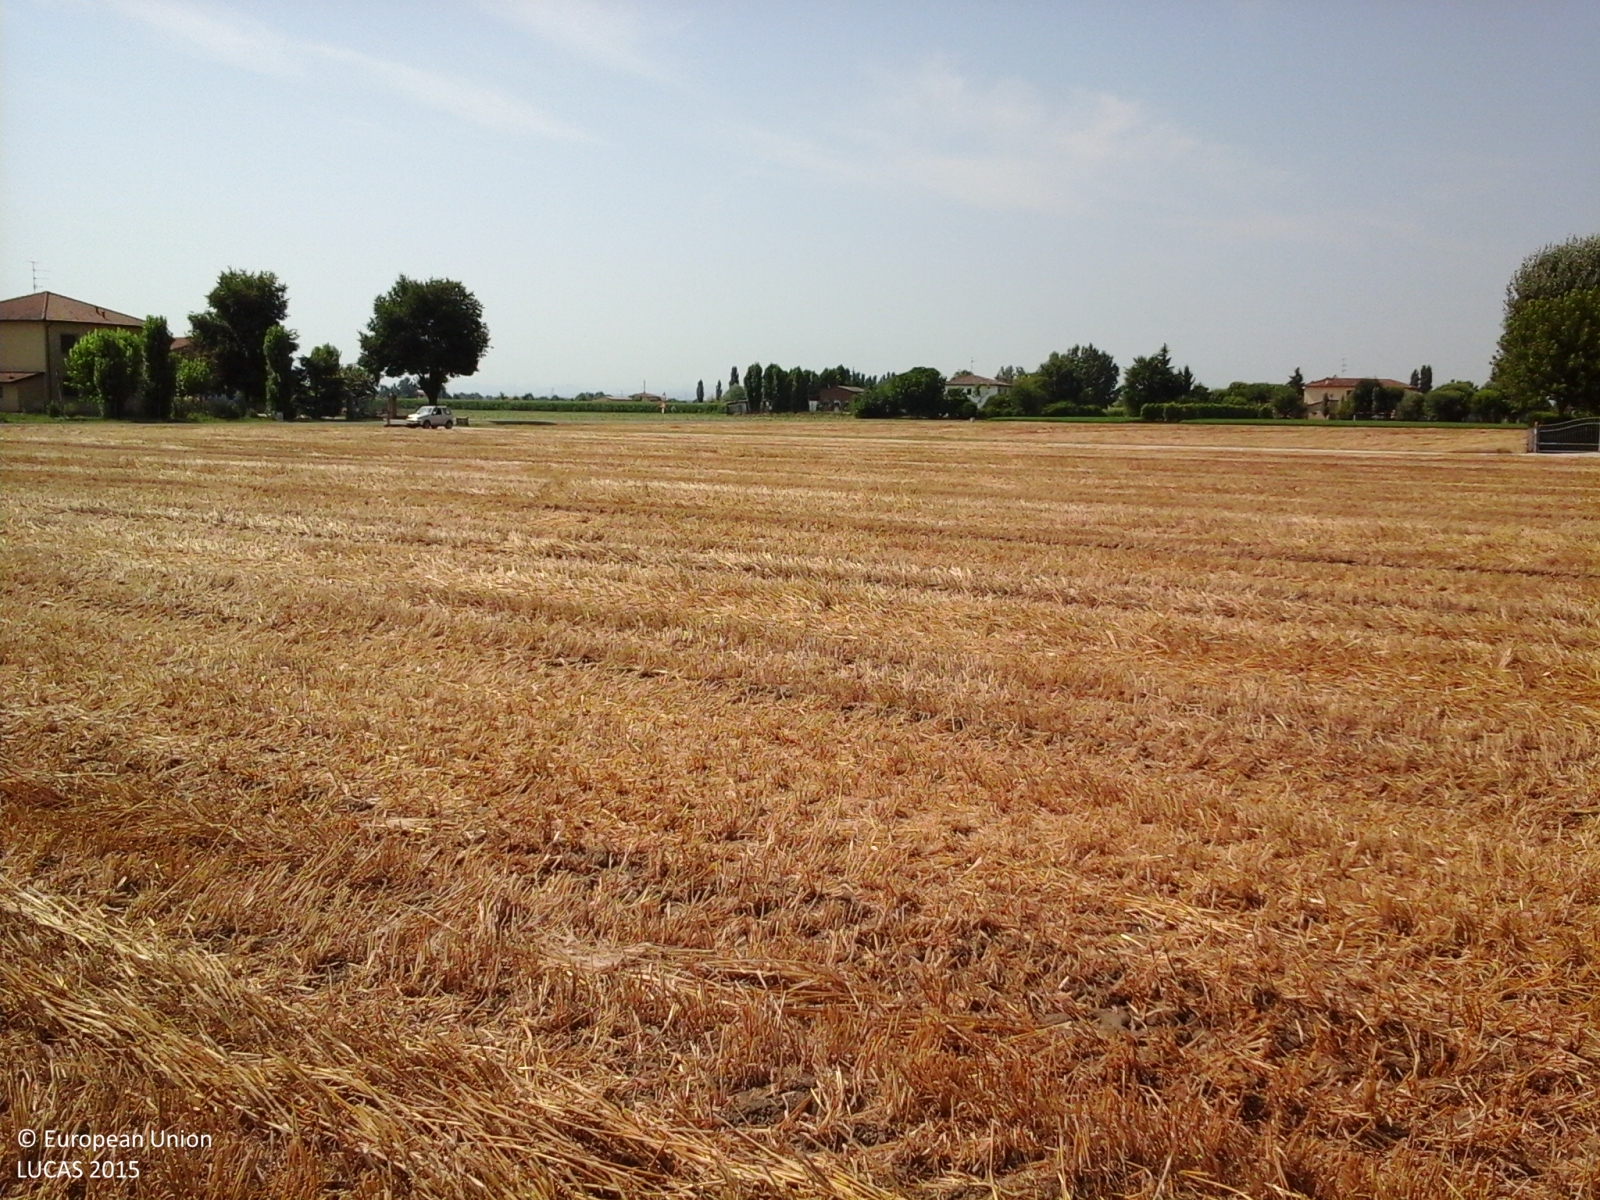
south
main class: Cropland
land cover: Common wheat
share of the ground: > 75 %
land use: Agriculture (excluding fallow land and kitchen gardens)
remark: Harvested field
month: July
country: IT
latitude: 44.5183
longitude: 11.6195
